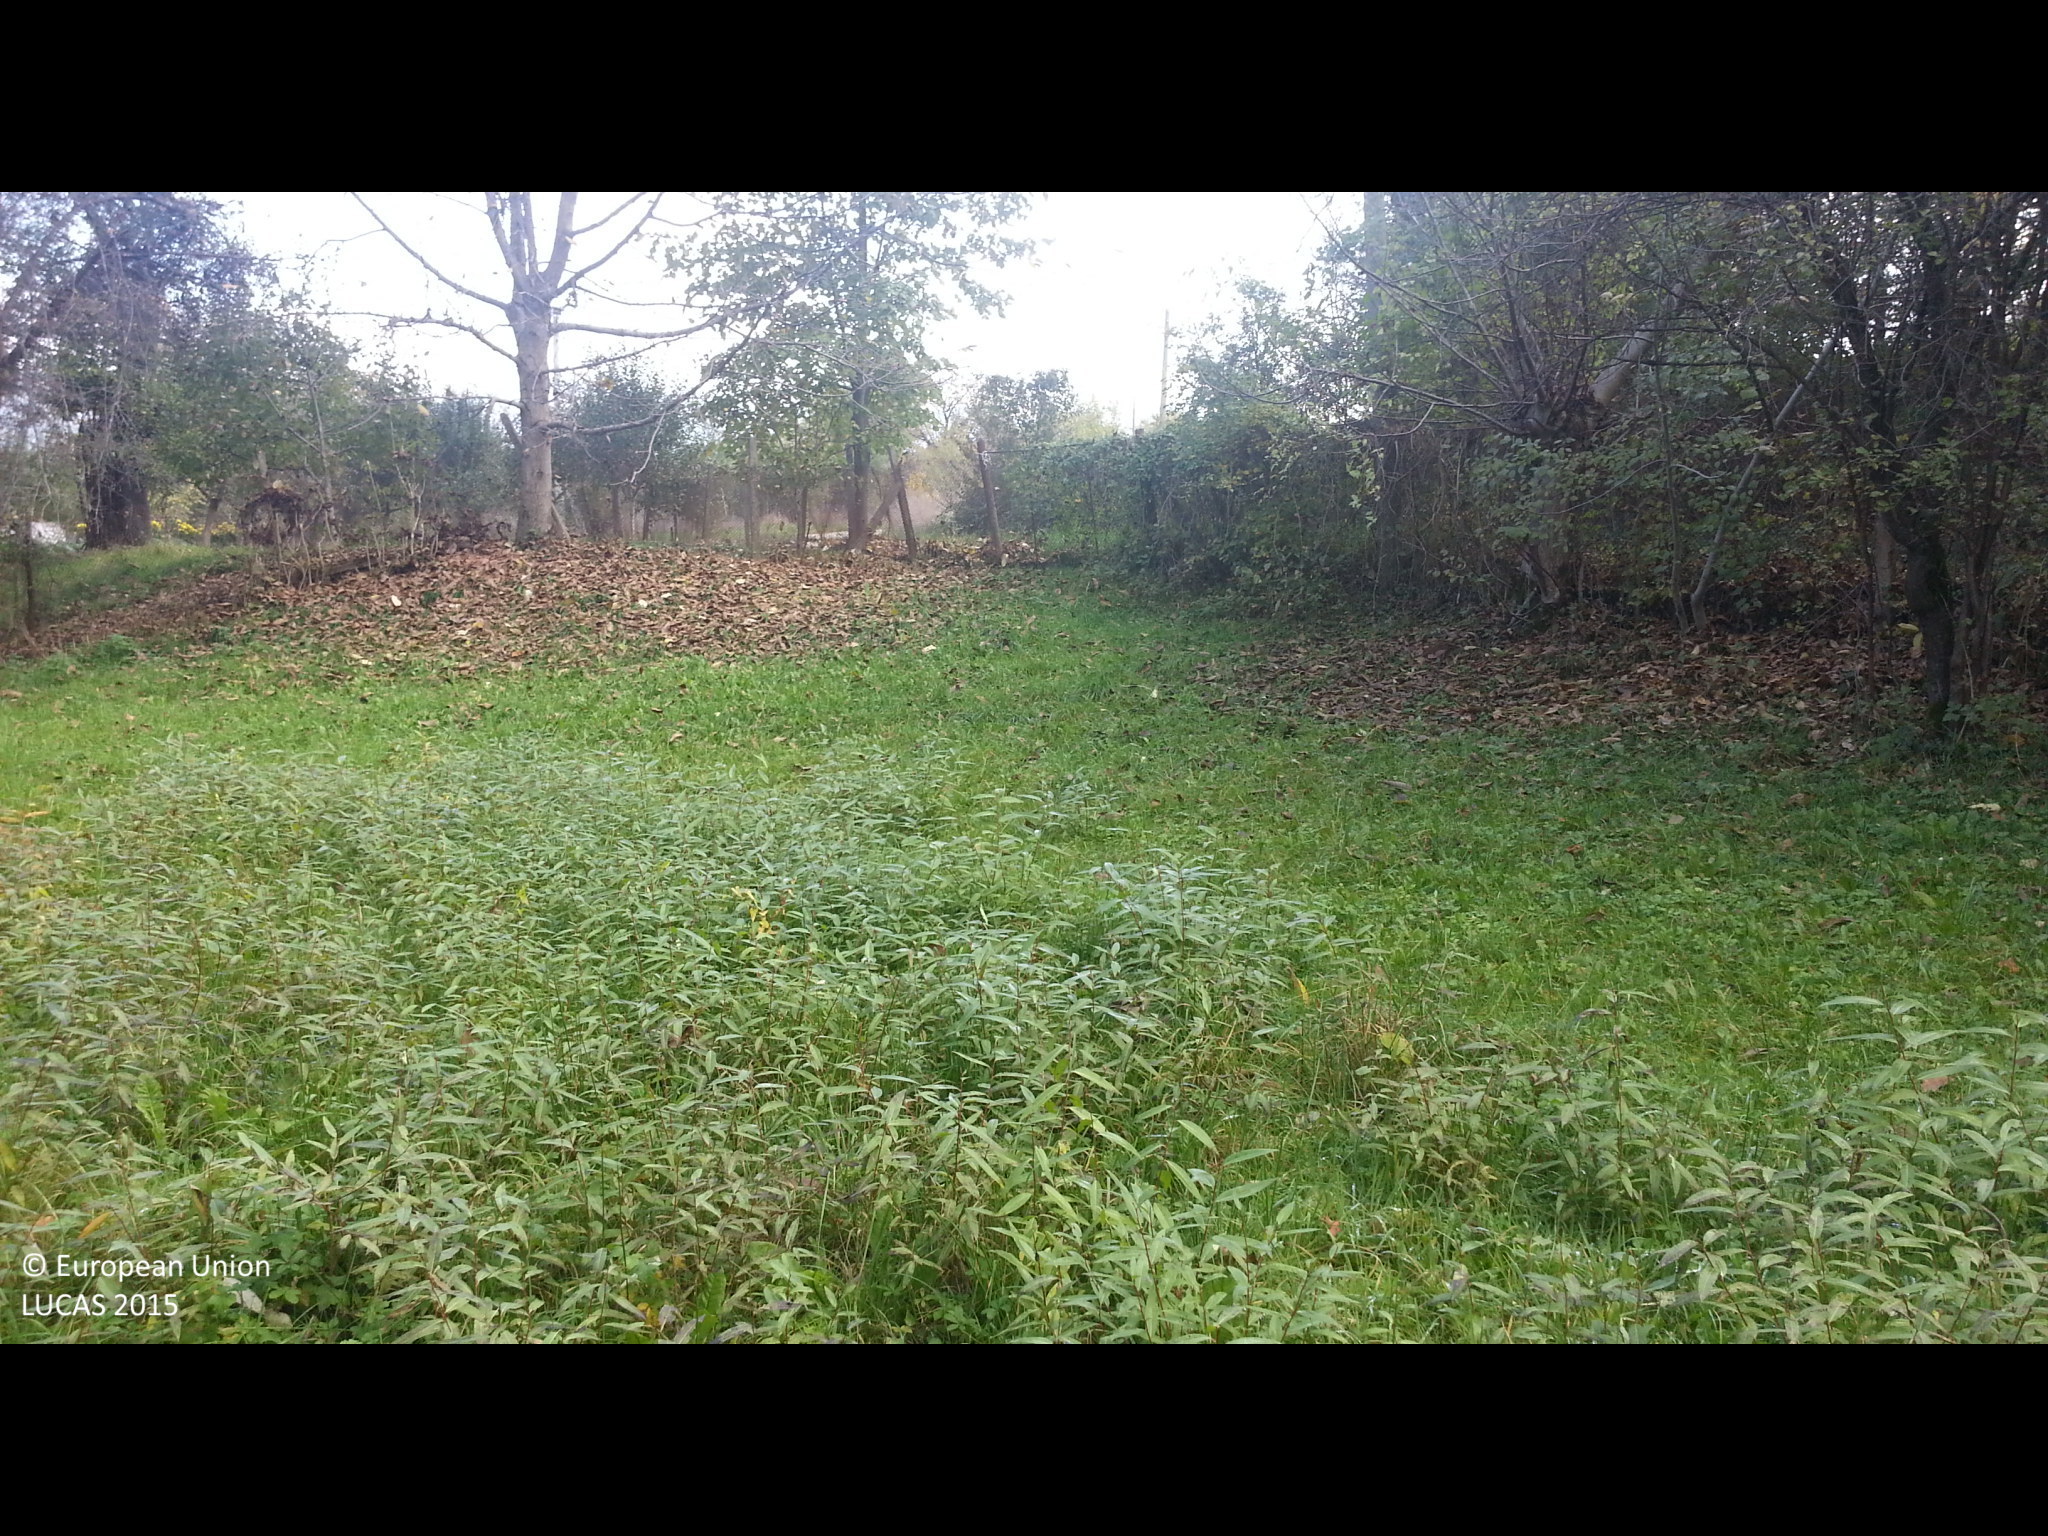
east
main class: Grassland
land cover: Grassland without tree/shrub cover
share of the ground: > 75 %
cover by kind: herbaceous plants 100 %
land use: Agriculture (excluding fallow land and kitchen gardens)
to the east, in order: Grassland without tree/shrub cover; Single bushes/trees; Fences; Paved roads, cycling and walking lanes; Grass margins; Shrubland with sparse tree cover; Grassland without tree/shrub cover; Artificial constructions in urban areas
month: November
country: BG
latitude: 42.8983
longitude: 23.8959
